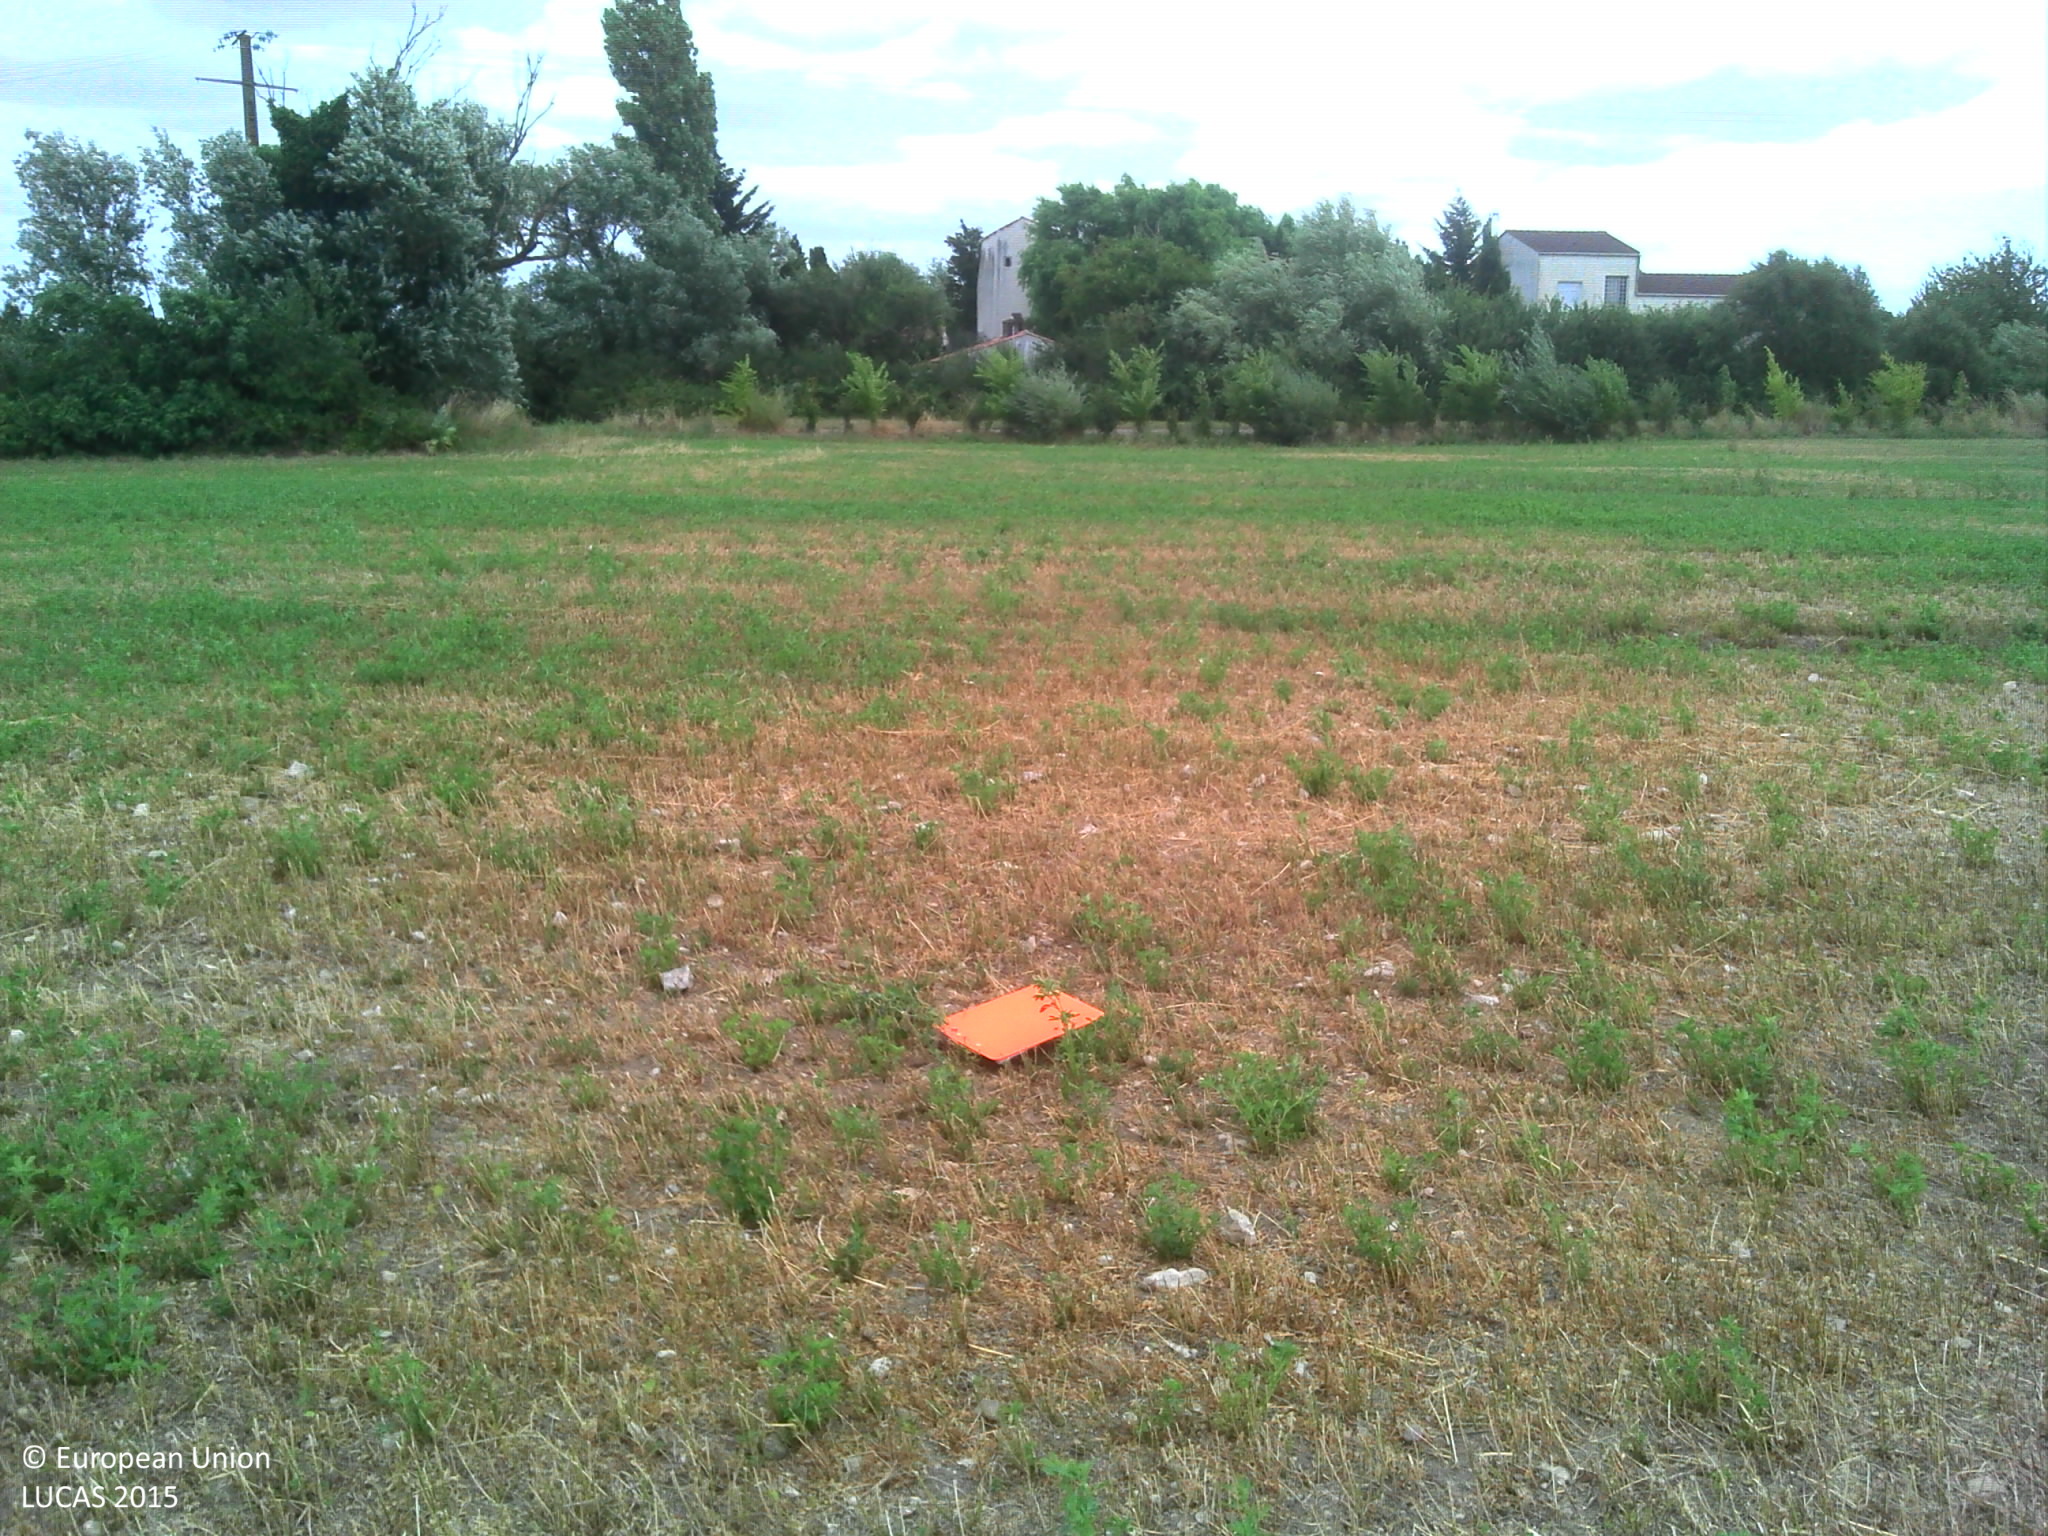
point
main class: Cropland
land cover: Lucerne
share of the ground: > 75 %
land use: Agriculture (excluding fallow land and kitchen gardens)
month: July
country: FR
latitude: 46.4035
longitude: -1.3123
